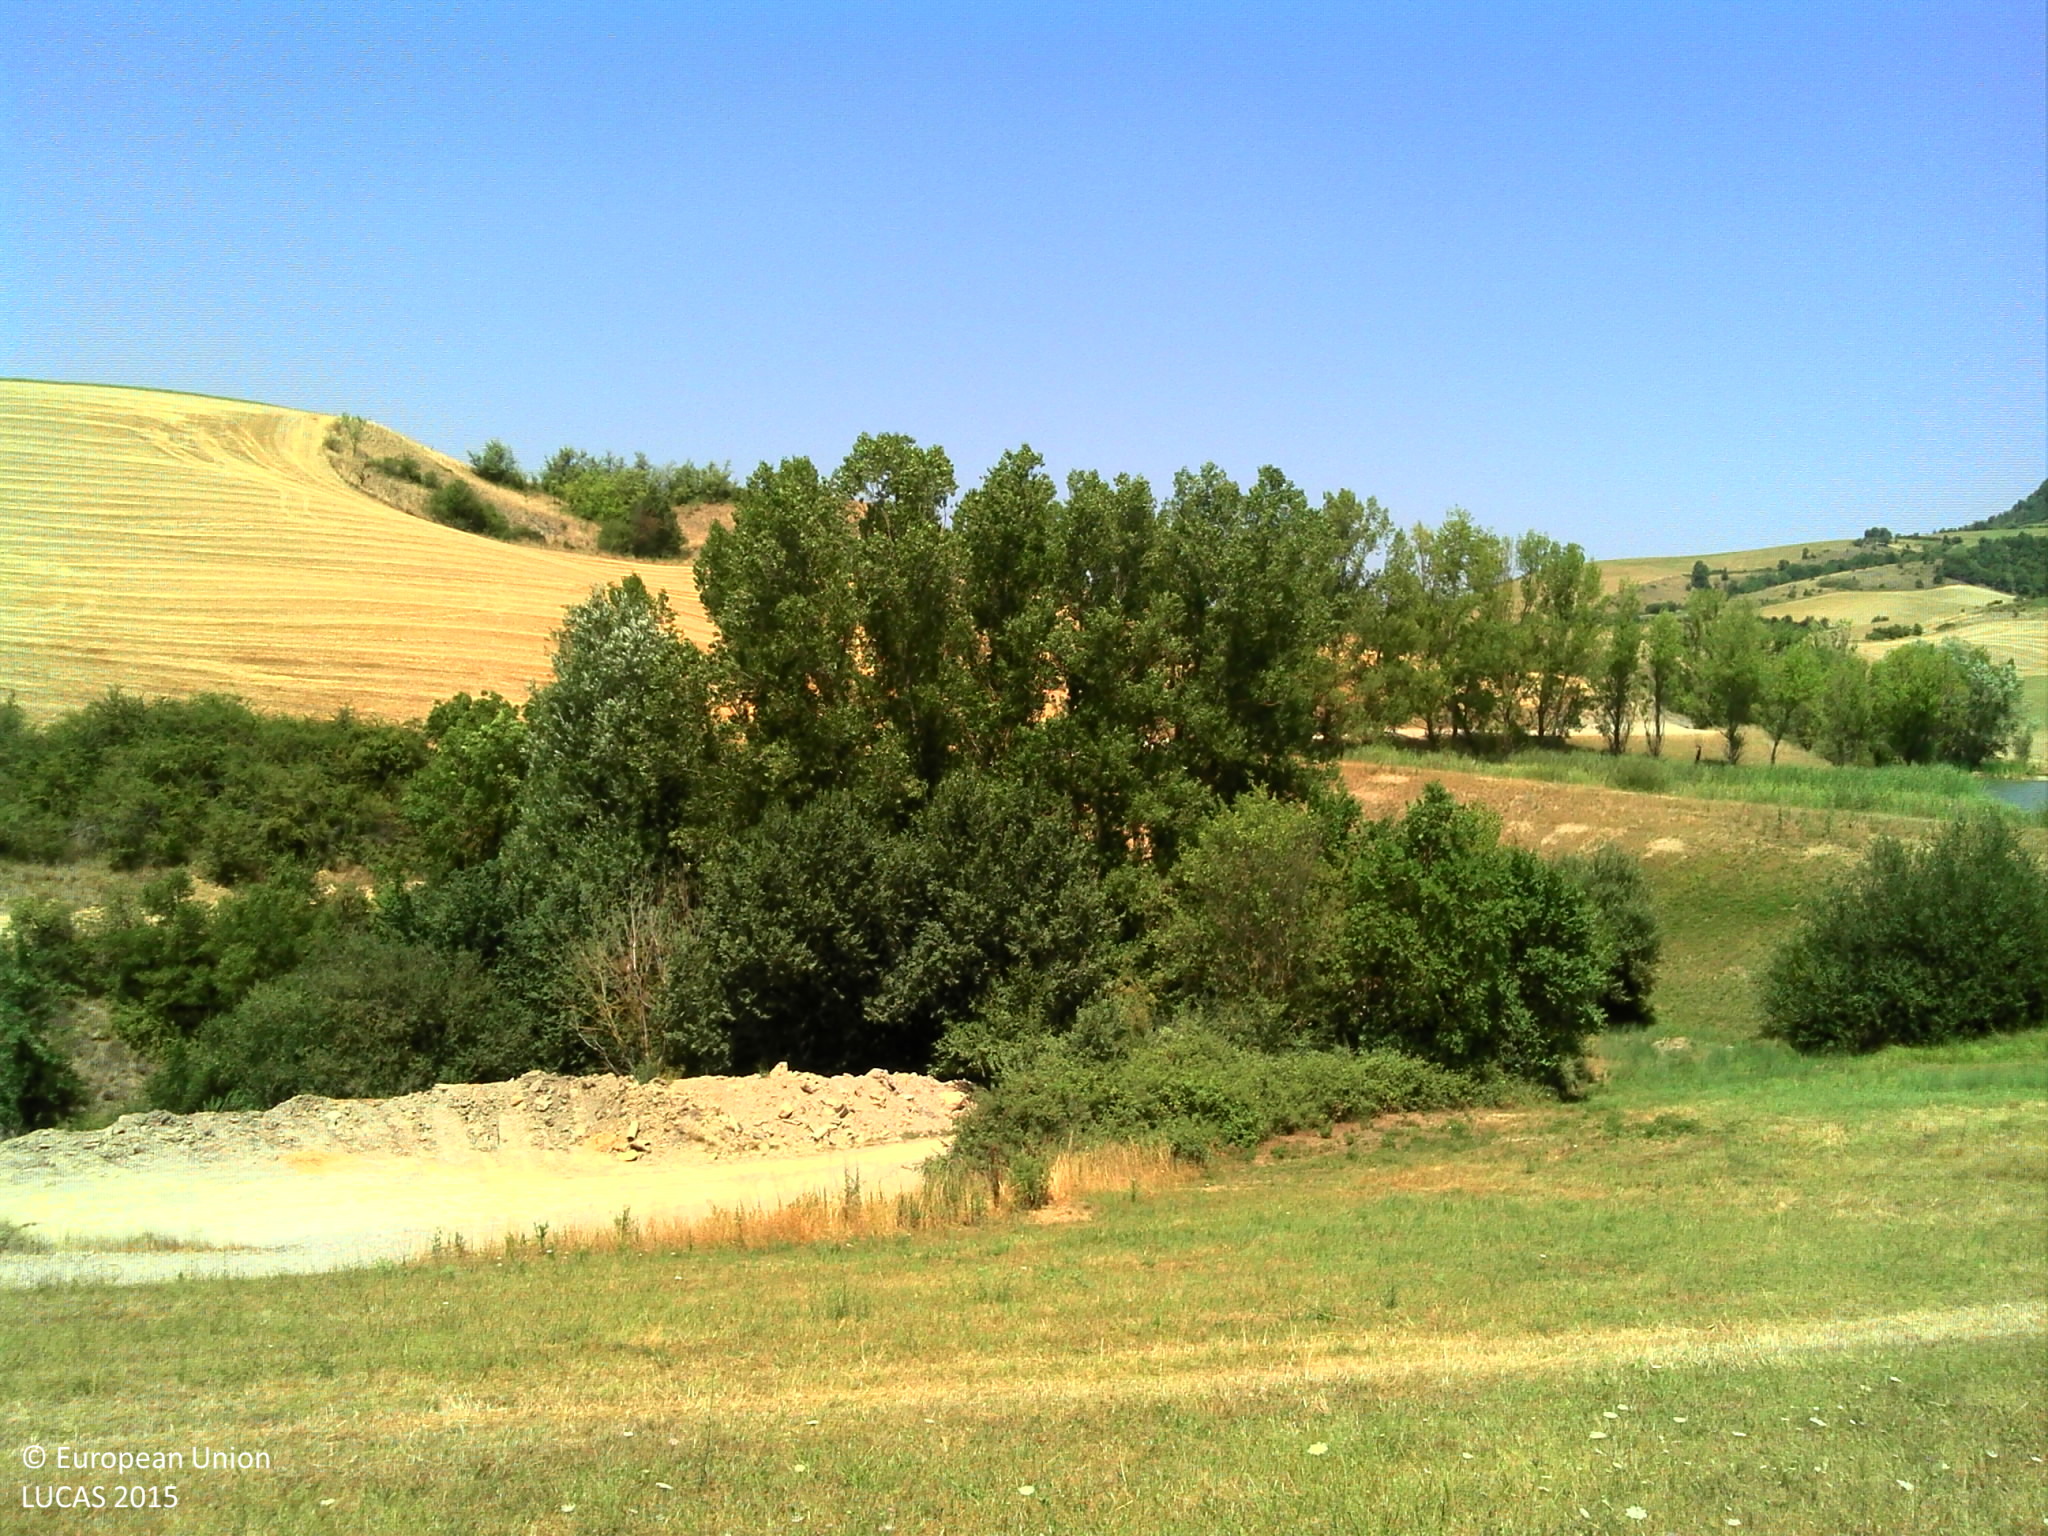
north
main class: Grassland
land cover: Grassland without tree/shrub cover
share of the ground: > 75 %
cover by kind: herbaceous plants 100 %
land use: Agriculture (excluding fallow land and kitchen gardens)
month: July
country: FR
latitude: 44.1743
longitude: 3.0889
